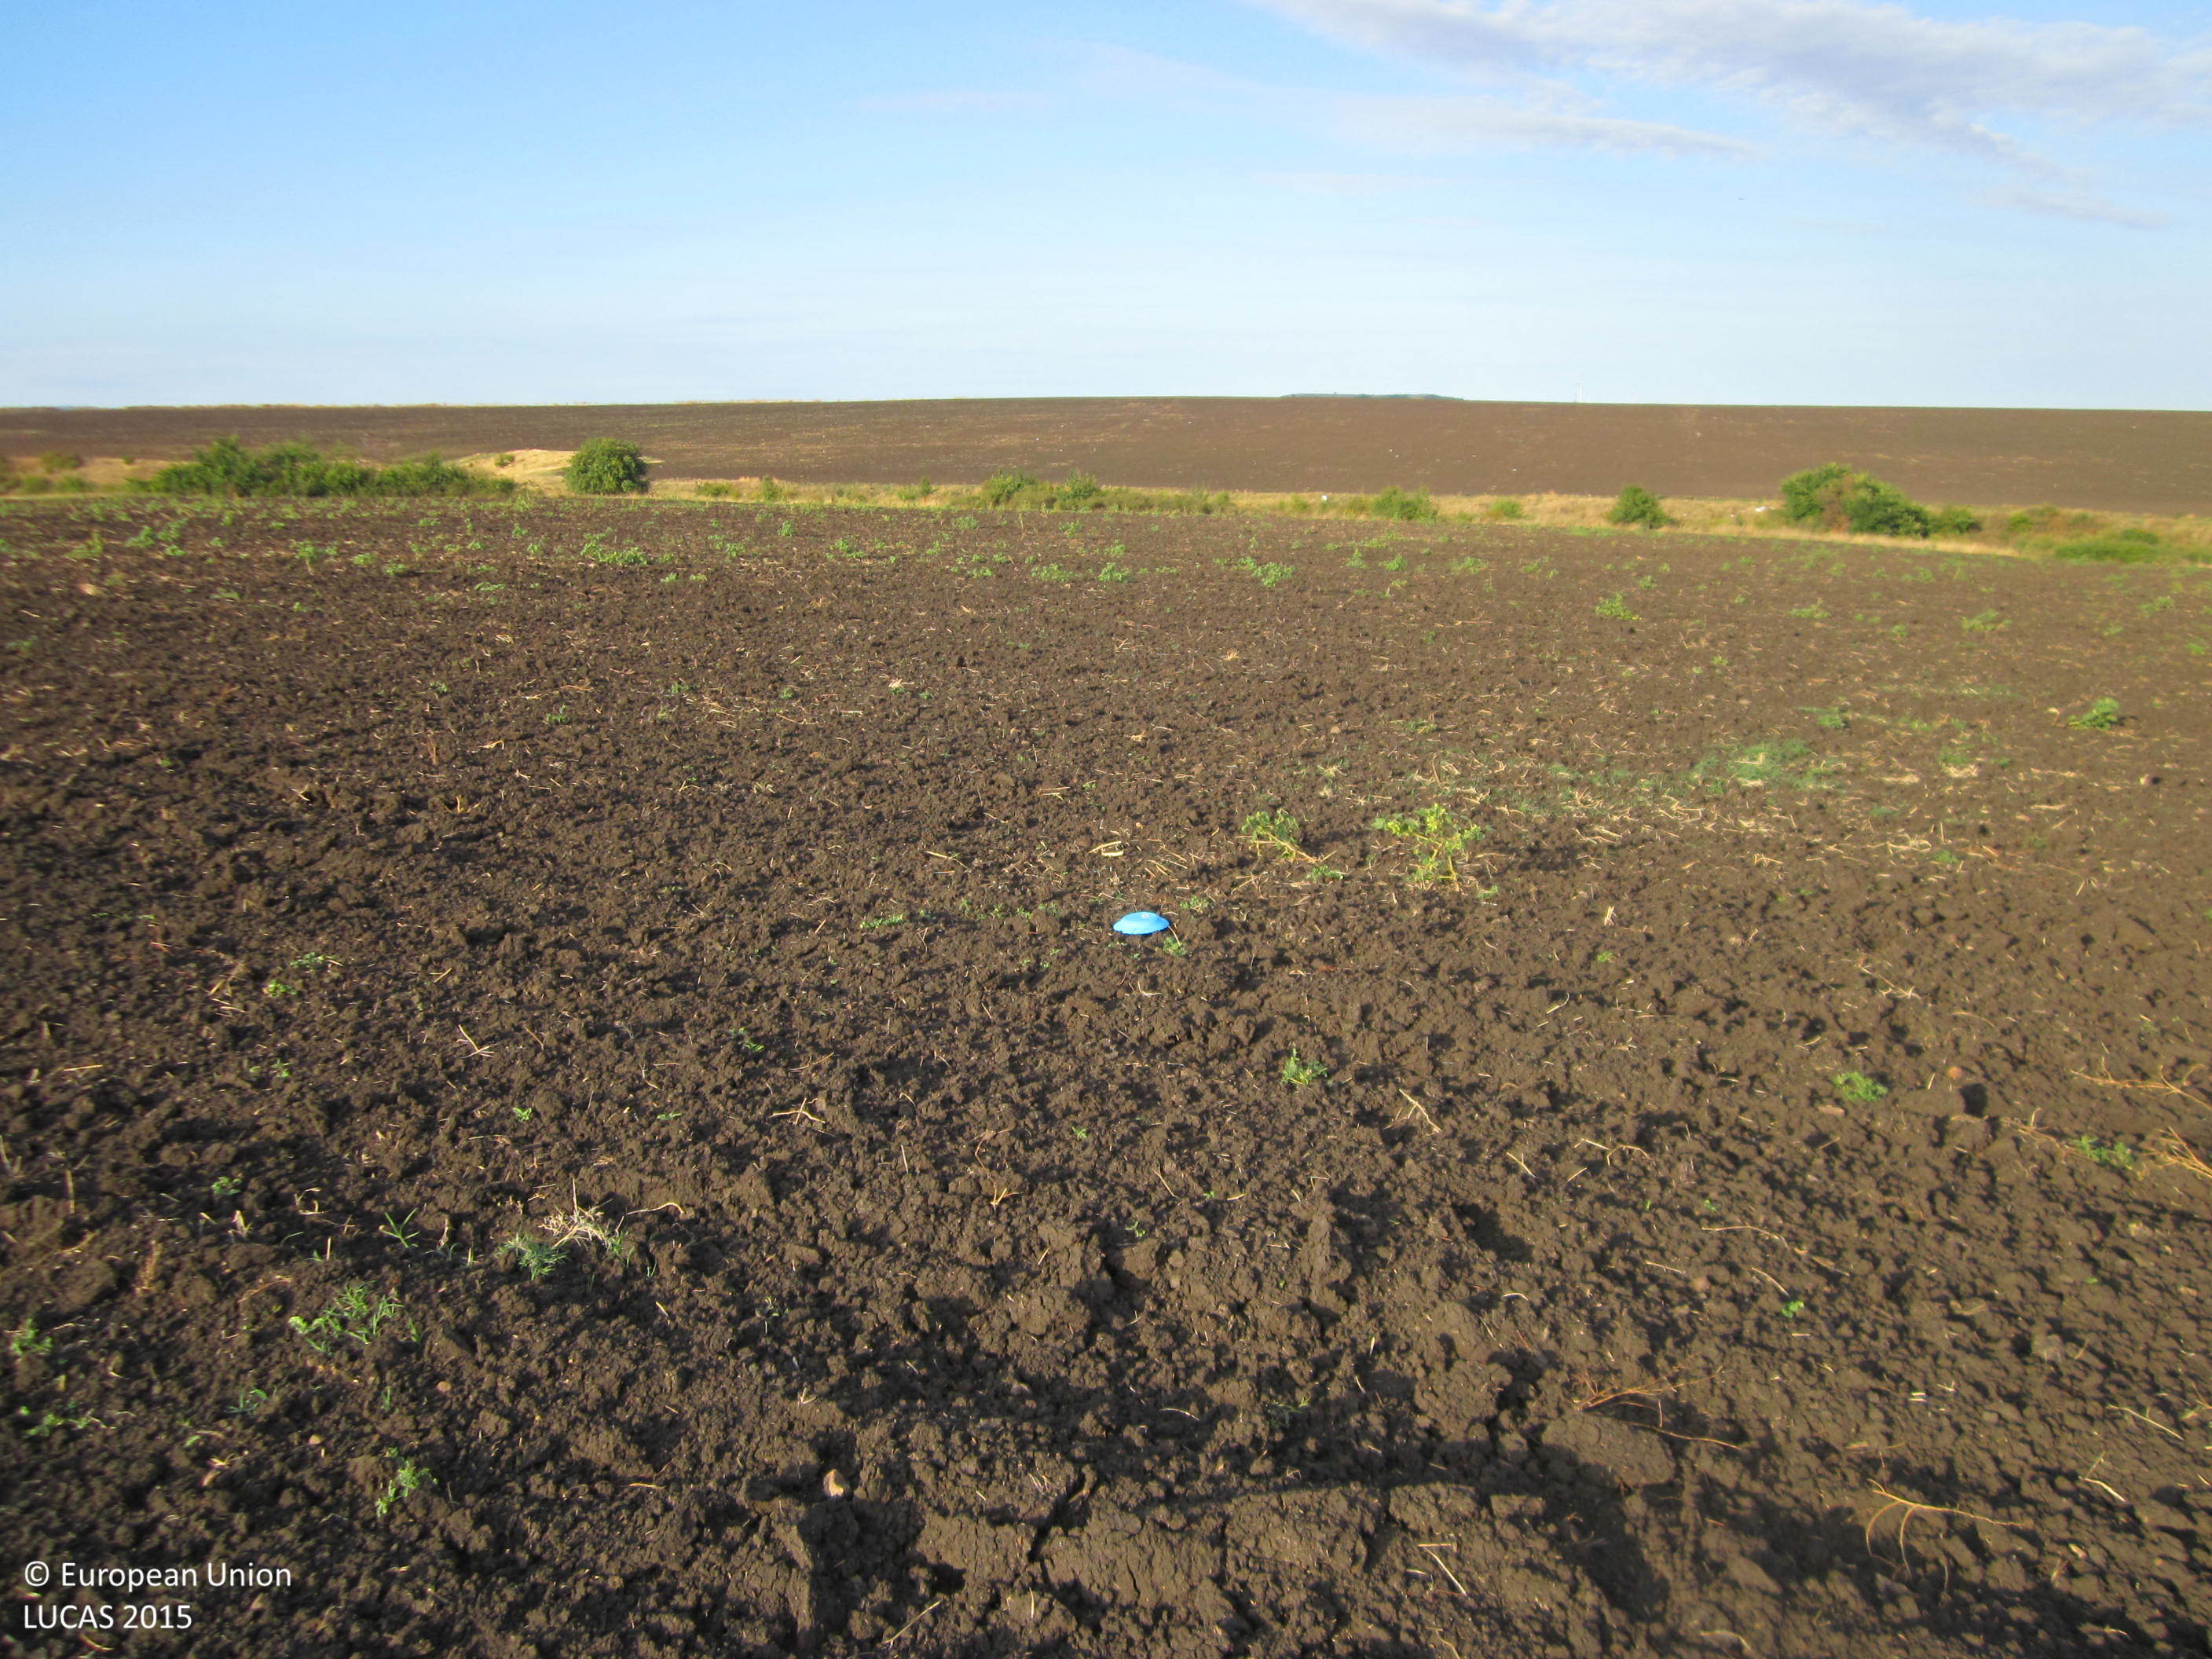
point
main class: Cropland
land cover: Sunflower
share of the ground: < 10 %
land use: Agriculture (excluding fallow land and kitchen gardens)
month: September
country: BG
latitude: 42.6207
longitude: 27.1171
